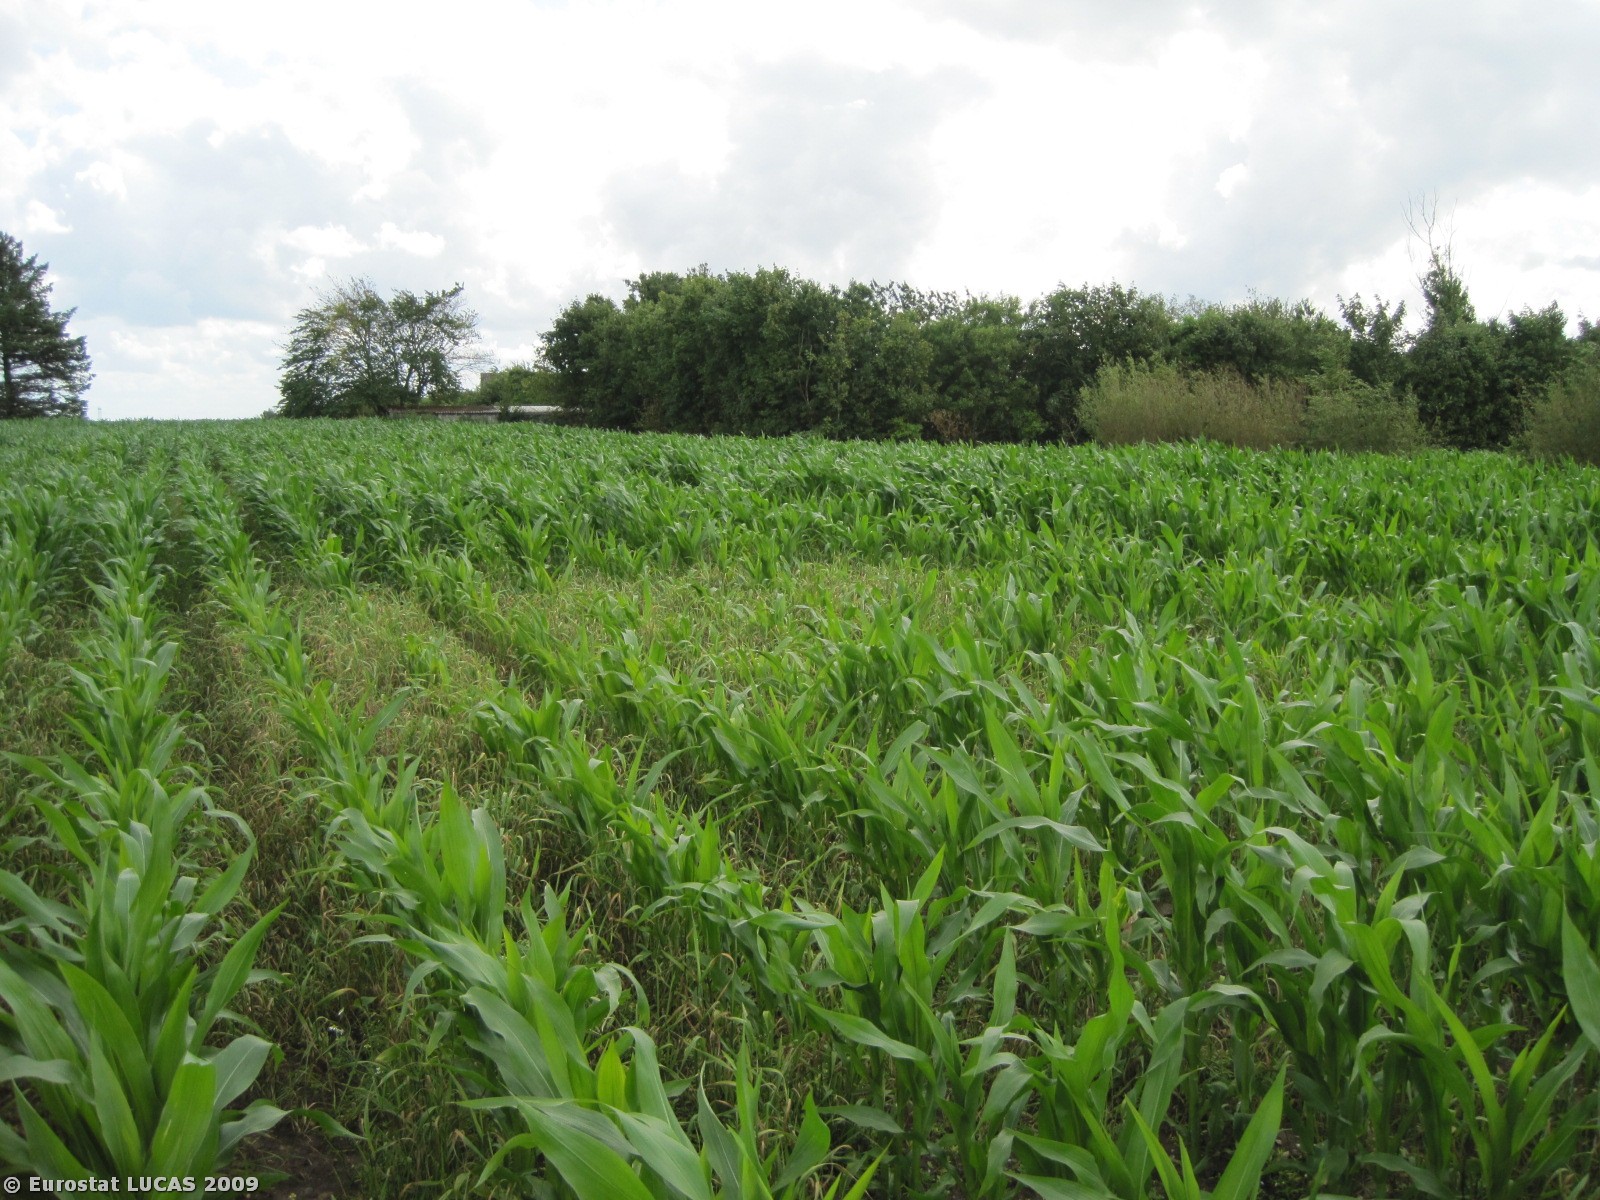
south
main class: Cropland
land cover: Maize
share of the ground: 25 - 50 %
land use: Agriculture (excluding fallow land and kitchen gardens)
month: July
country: DK
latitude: 56.4354
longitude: 8.9796
